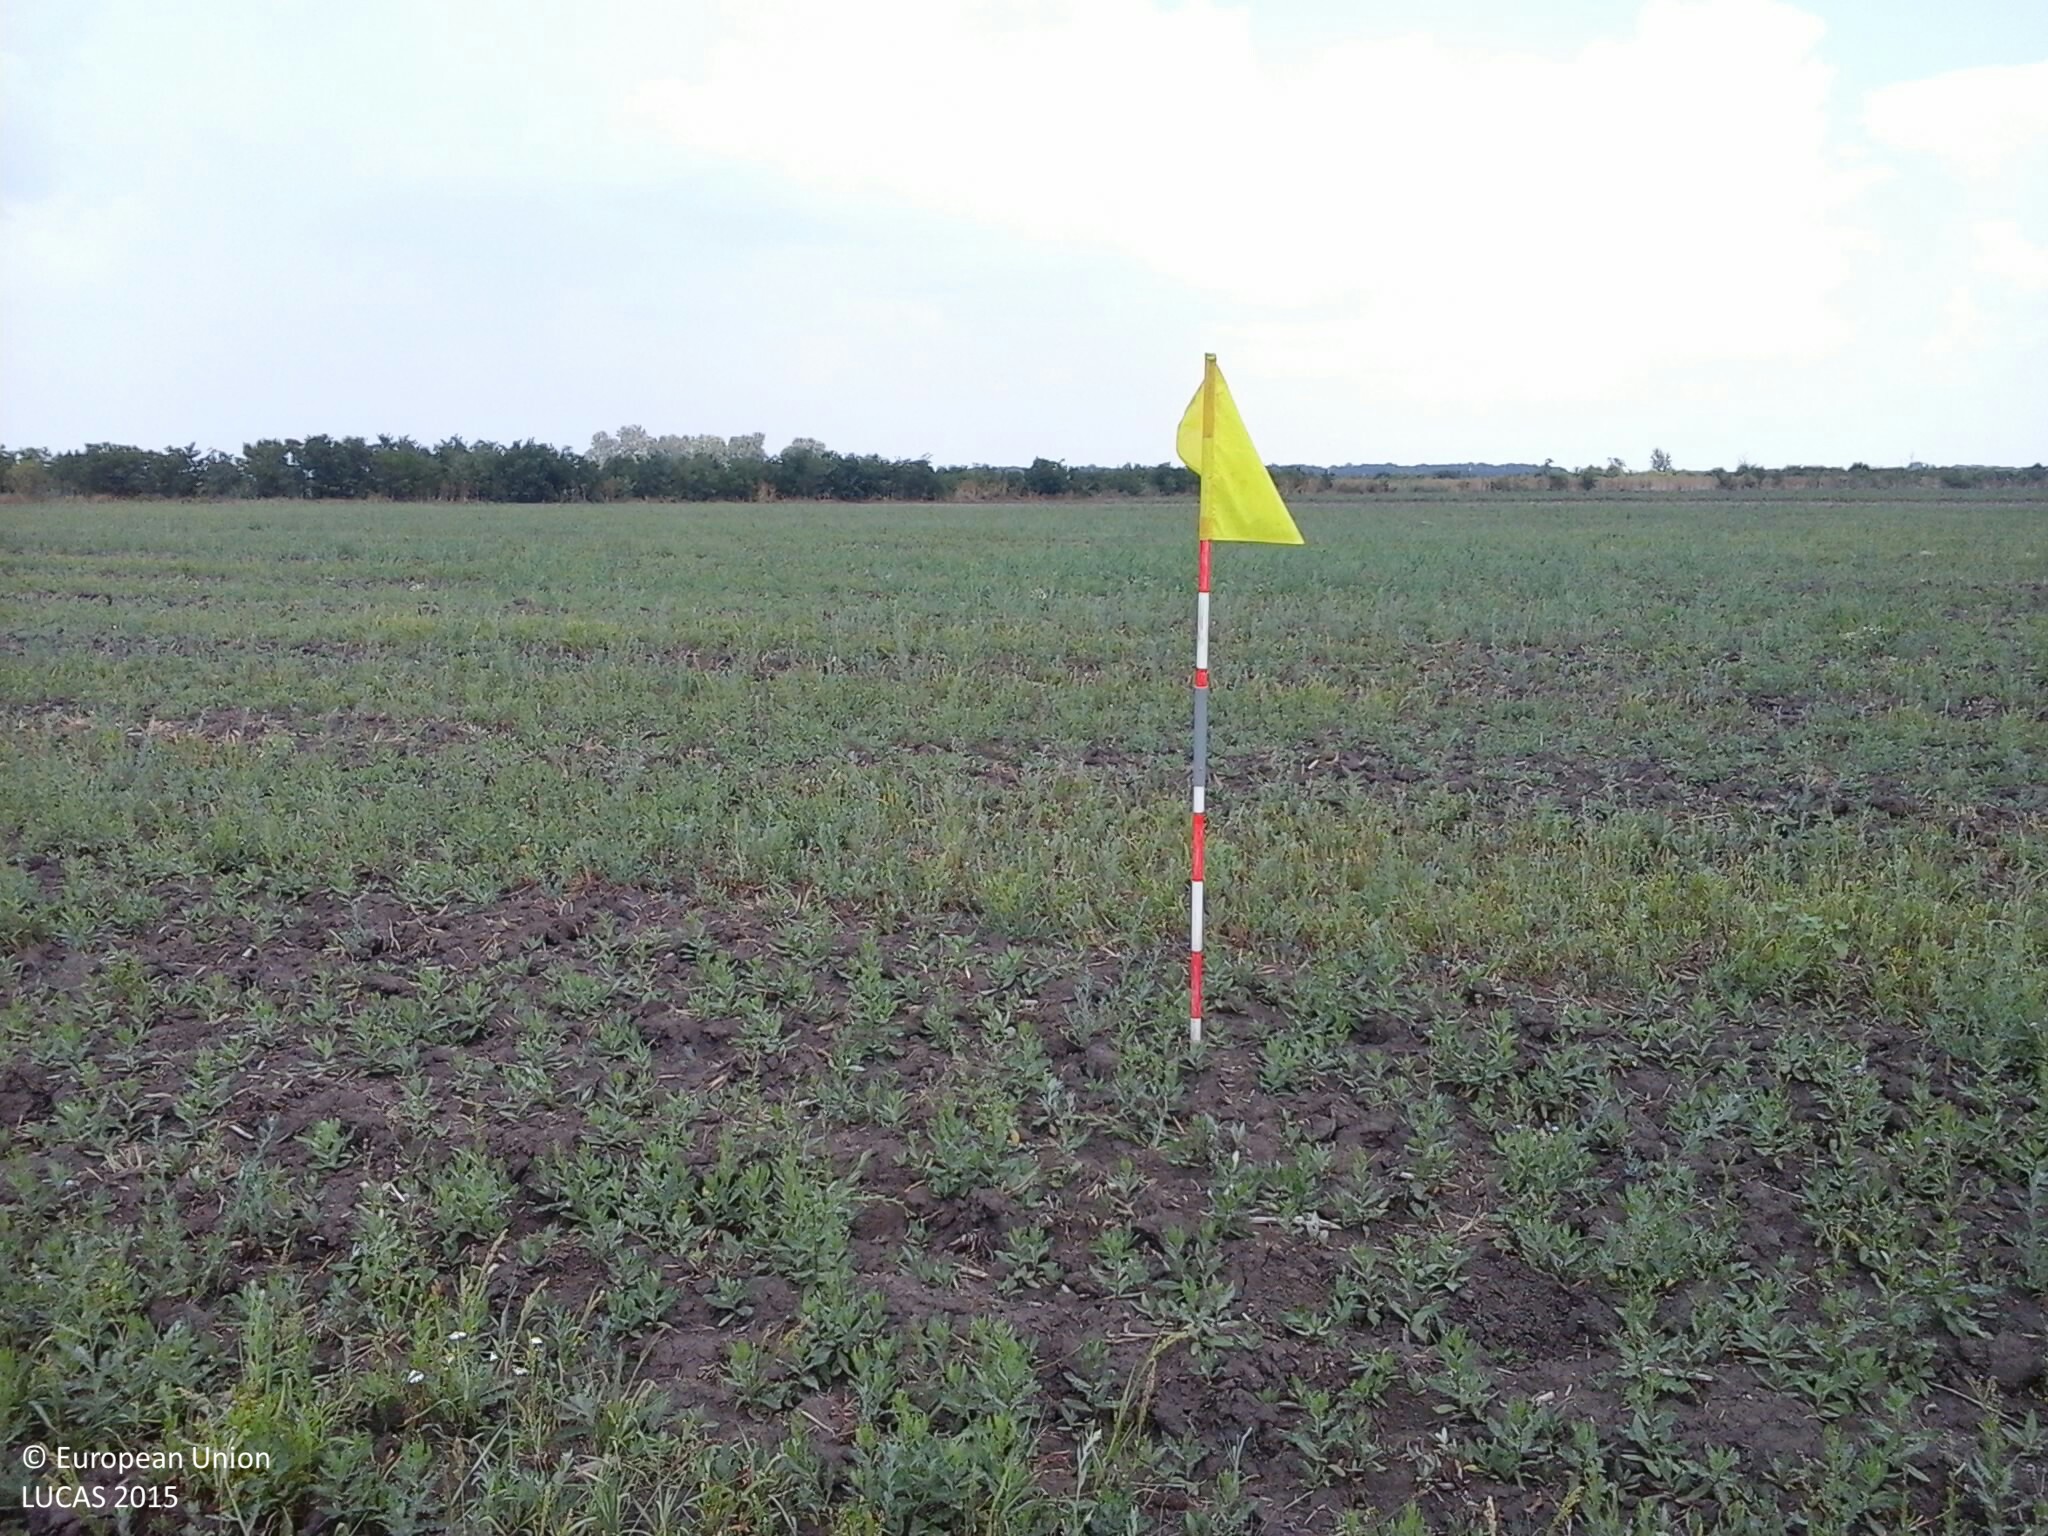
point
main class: Grassland
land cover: Spontaneously vegetated surfaces
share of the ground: 50 - 75 %
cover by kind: herbaceous plants 60 %, unconsolidated bare surface 40 %
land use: Fallow land
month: August
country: HU
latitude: 47.6030
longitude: 20.9569
